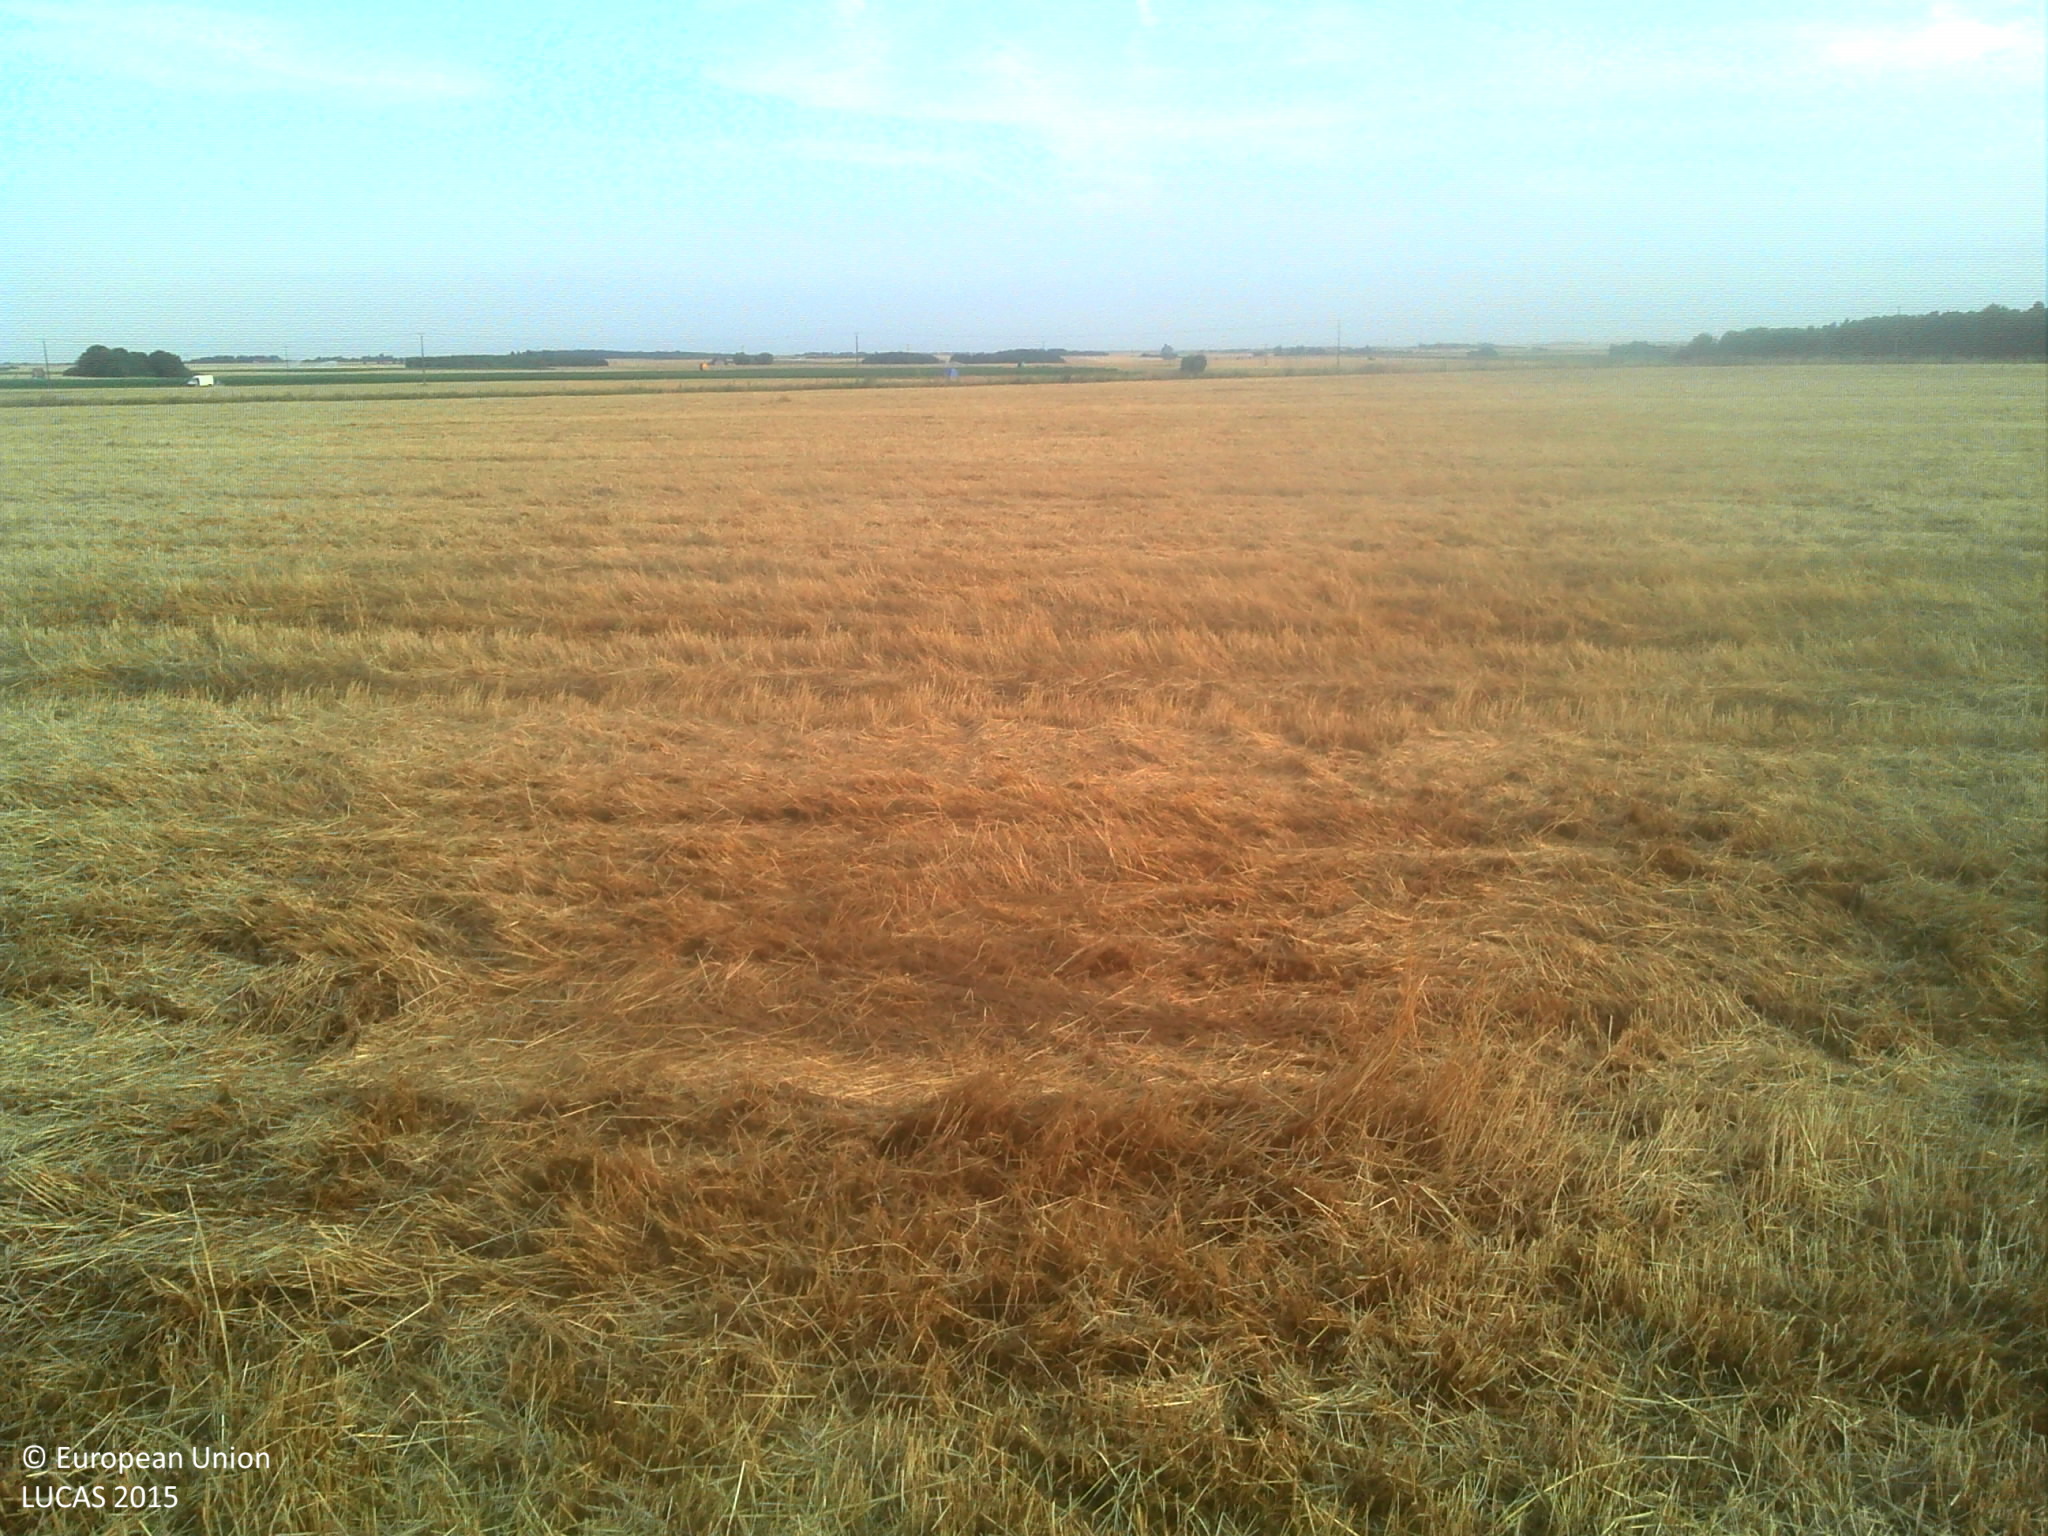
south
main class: Cropland
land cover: Durum wheat
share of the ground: > 75 %
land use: Agriculture (excluding fallow land and kitchen gardens)
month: July
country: FR
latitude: 47.8165
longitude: 1.4237
